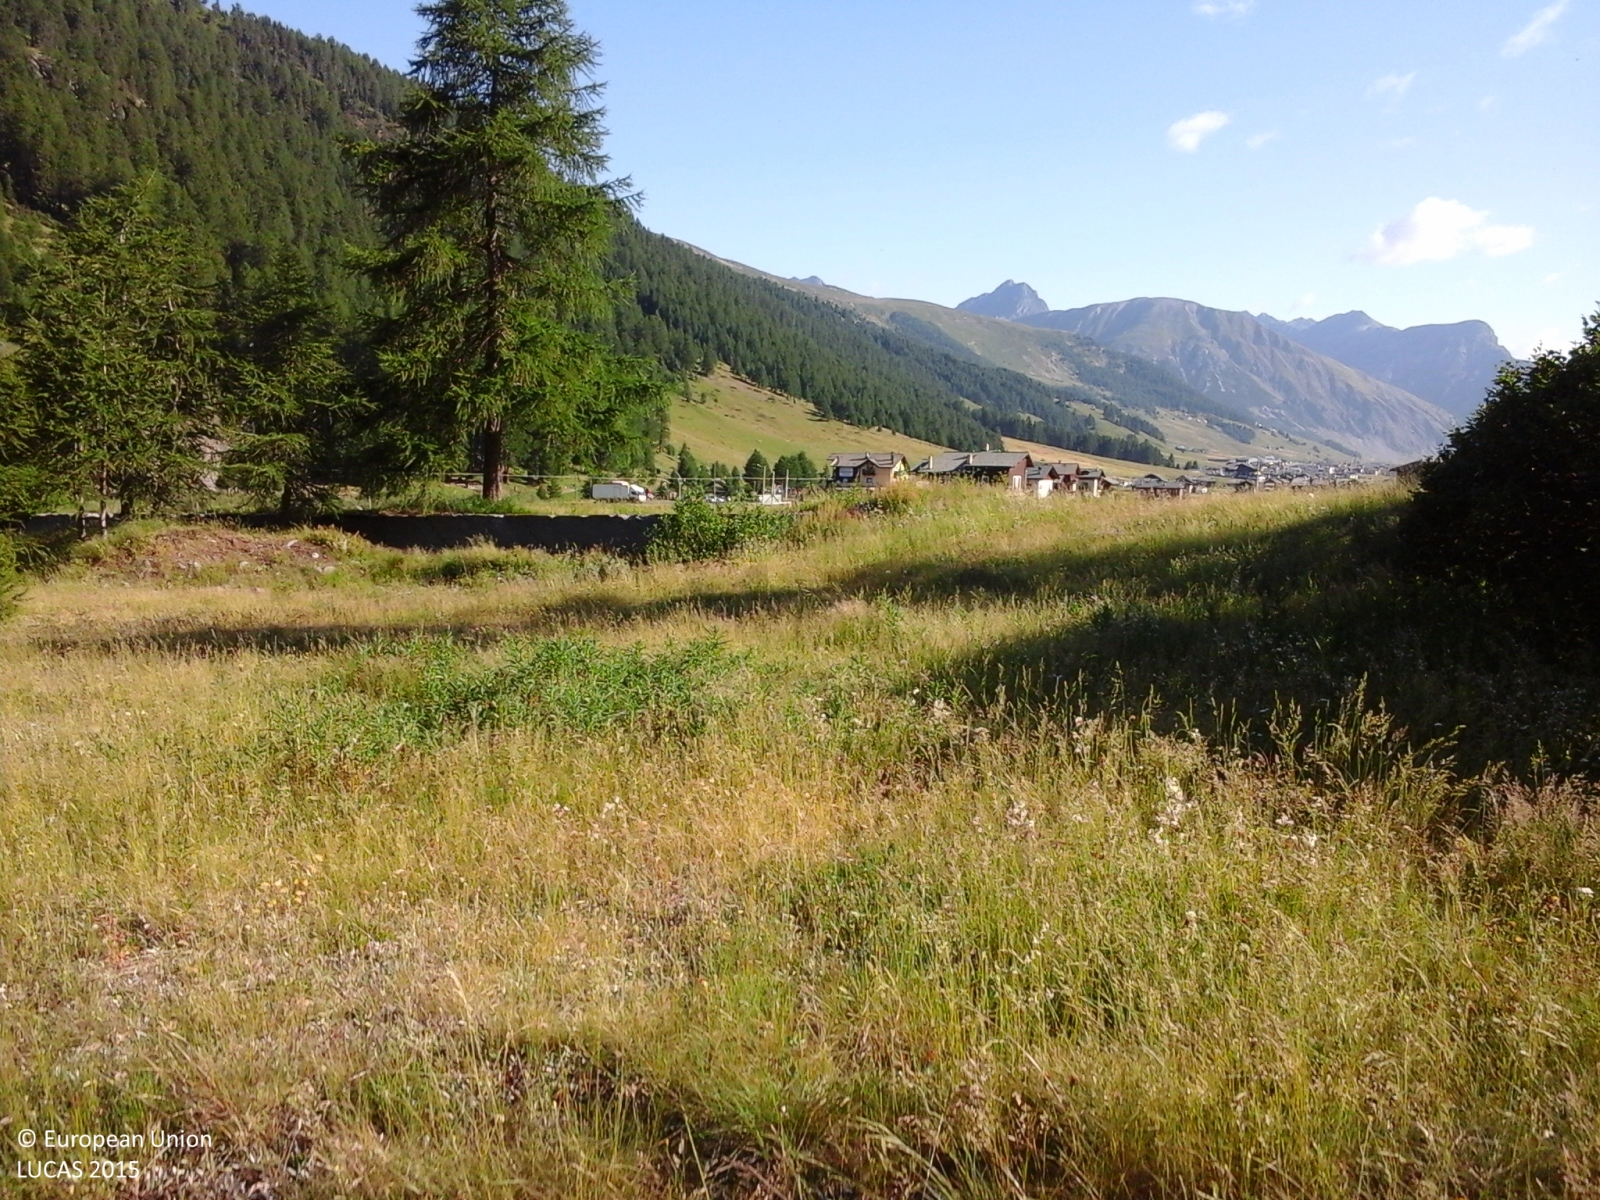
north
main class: Woodland
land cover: Other coniferous woodland
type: alpine coniferous forest
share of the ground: > 75 %
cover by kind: herbaceous plants 80 %, coniferous forest trees 20 %
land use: Agriculture (excluding fallow land and kitchen gardens)
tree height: > 5 m
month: July
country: IT
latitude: 46.4952
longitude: 10.1171
